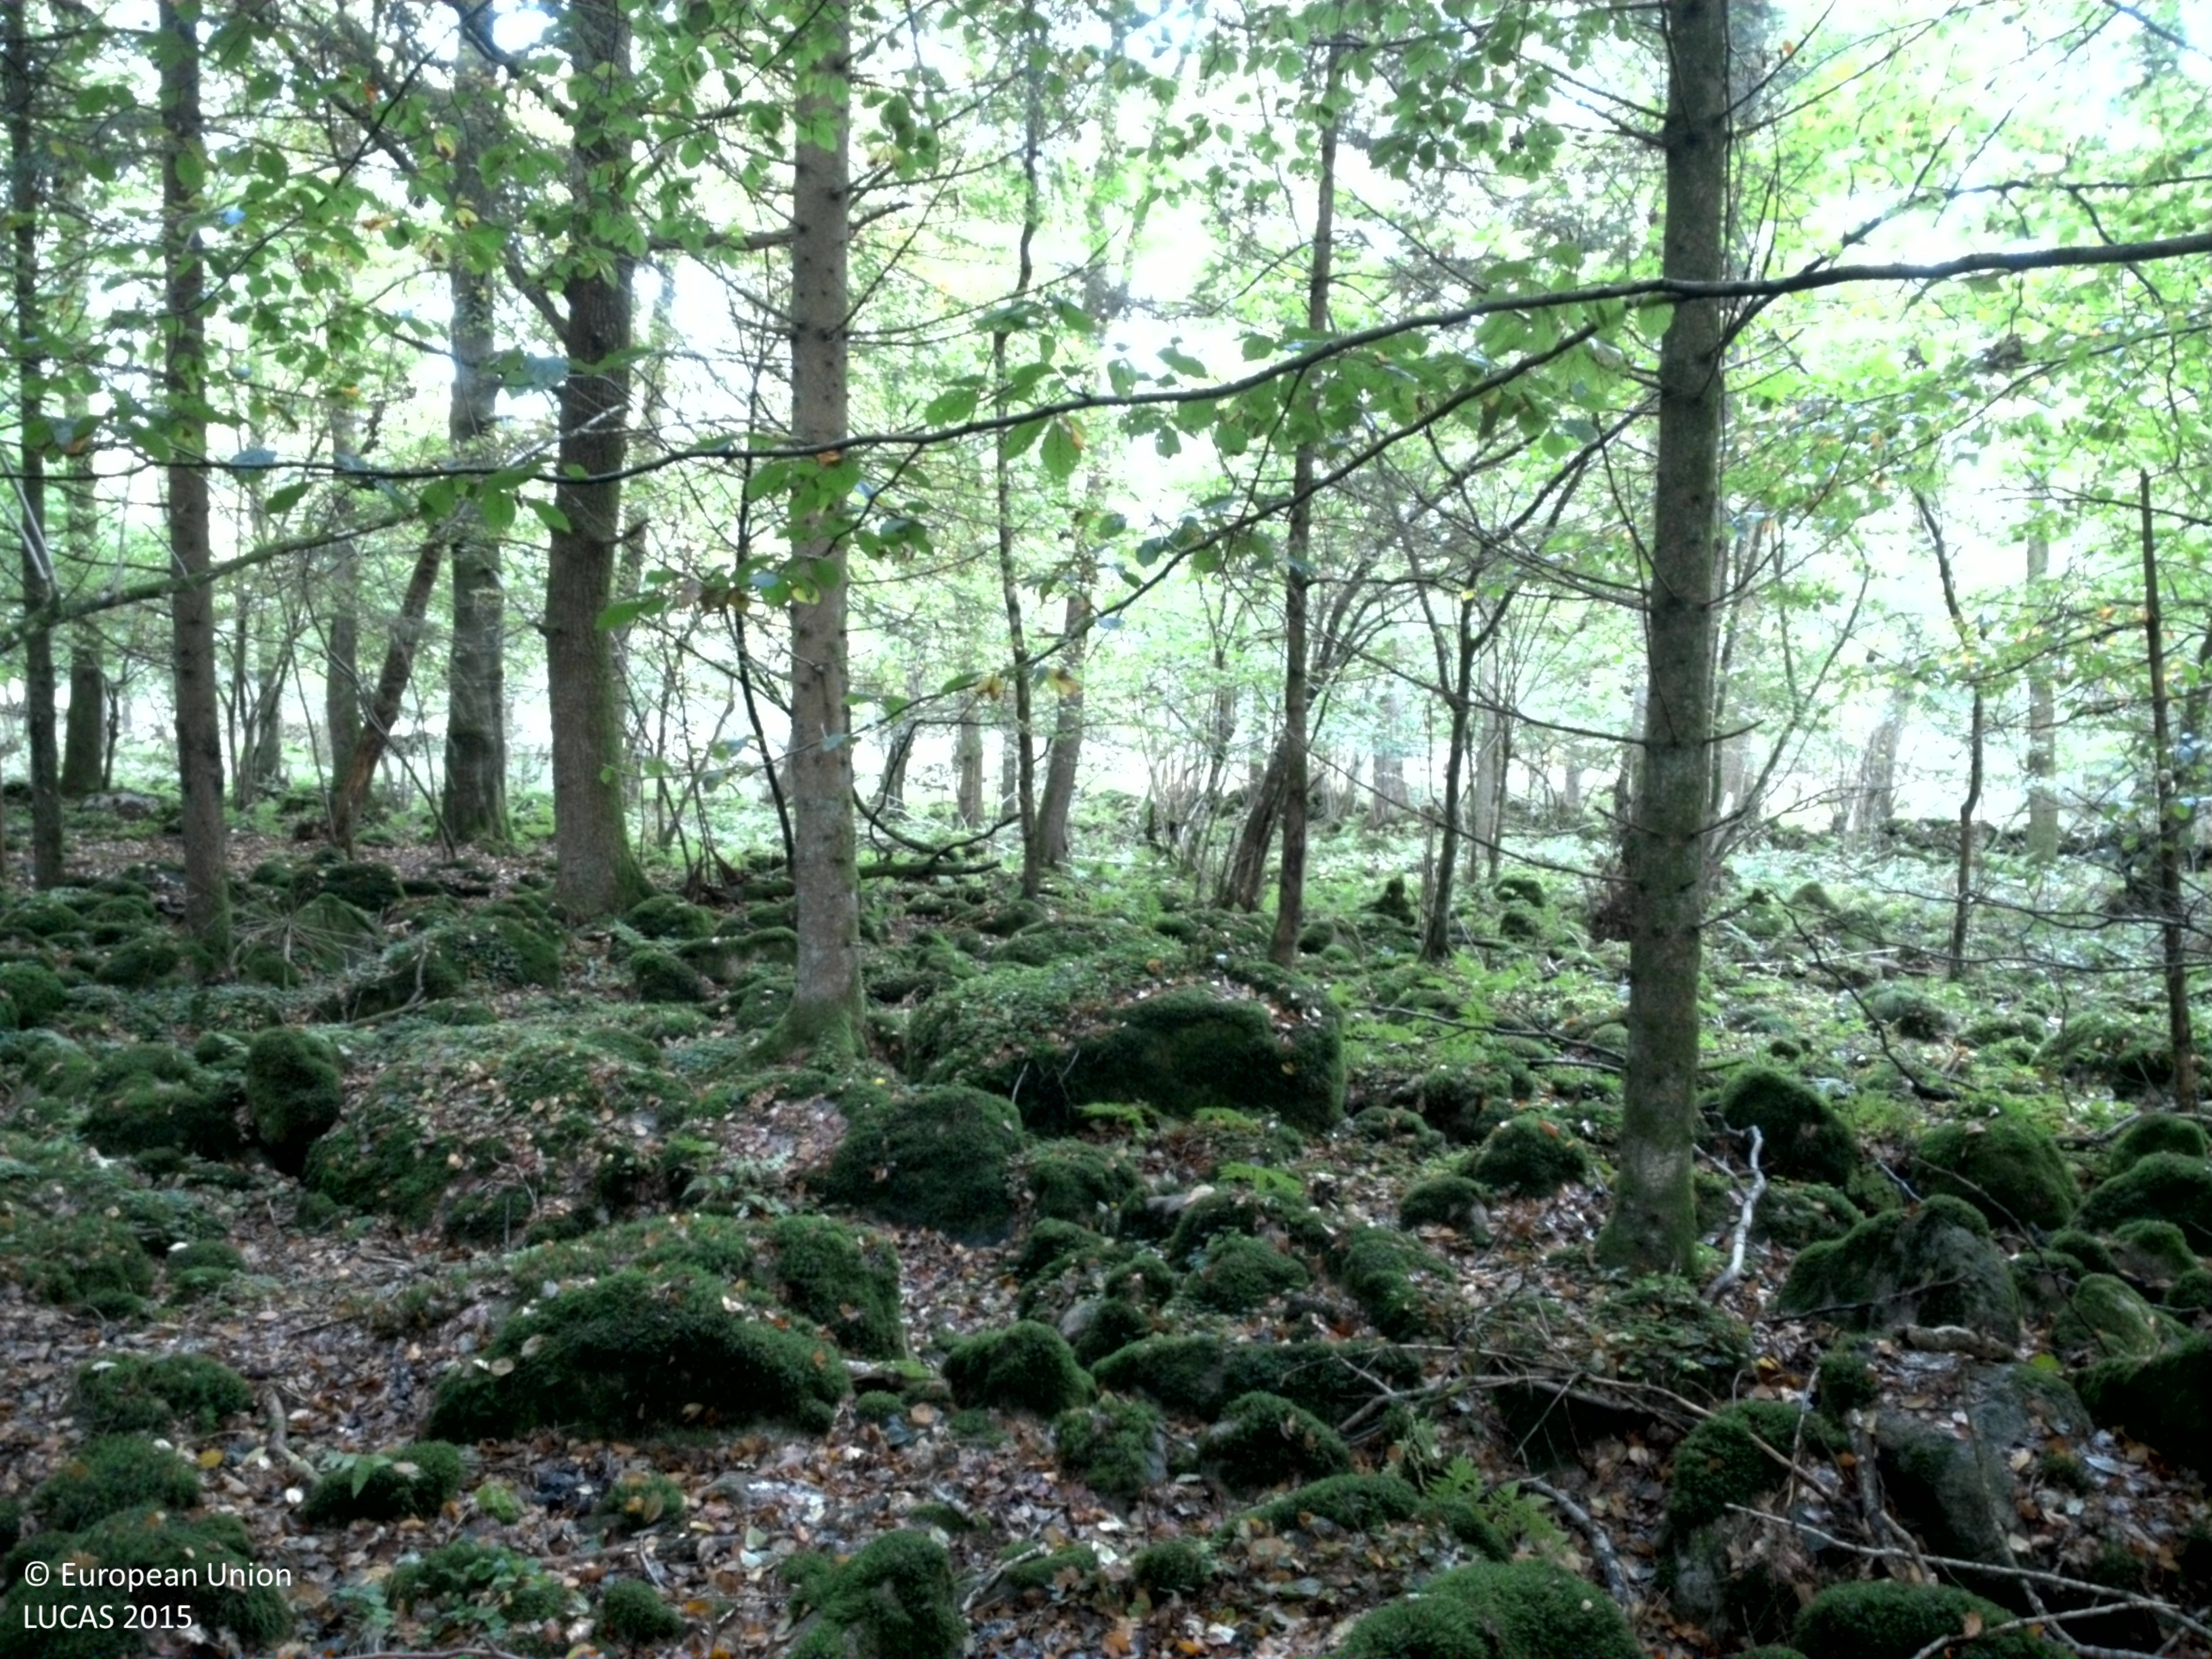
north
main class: Woodland
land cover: Broadleaved woodland
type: mesophytic deciduous forest
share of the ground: > 75 %
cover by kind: broadleaved forest trees 75 %, coniferous forest trees 5 %, shrubs 5 %, herbaceous plants 5 %, lichens and mosses 5 %, unconsolidated bare surface 5 %
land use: Forestry
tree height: > 5 m
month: October
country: SE
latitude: 55.6938
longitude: 13.9914
